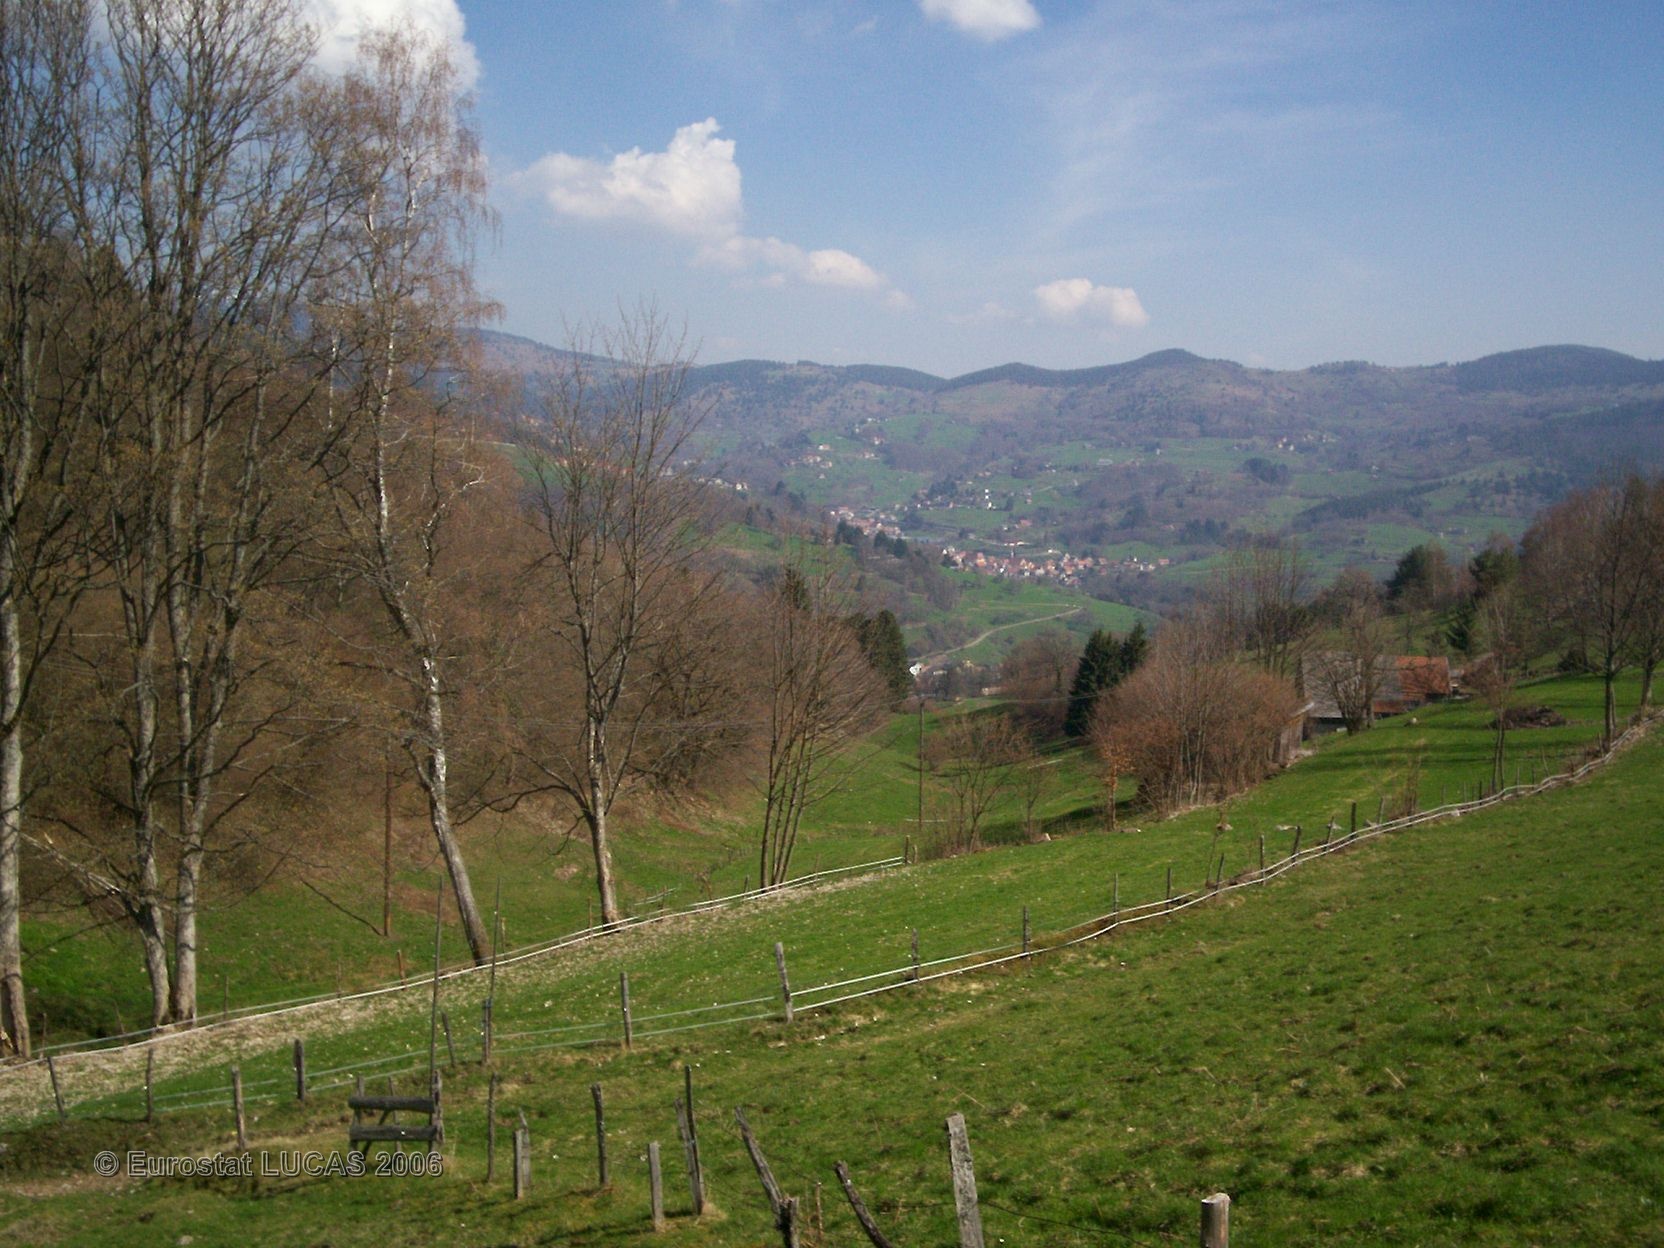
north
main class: Grassland
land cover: Grassland without tree/shrub cover
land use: Agriculture (excluding fallow land and kitchen gardens)
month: April
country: FR
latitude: 48.0411
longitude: 7.0905
